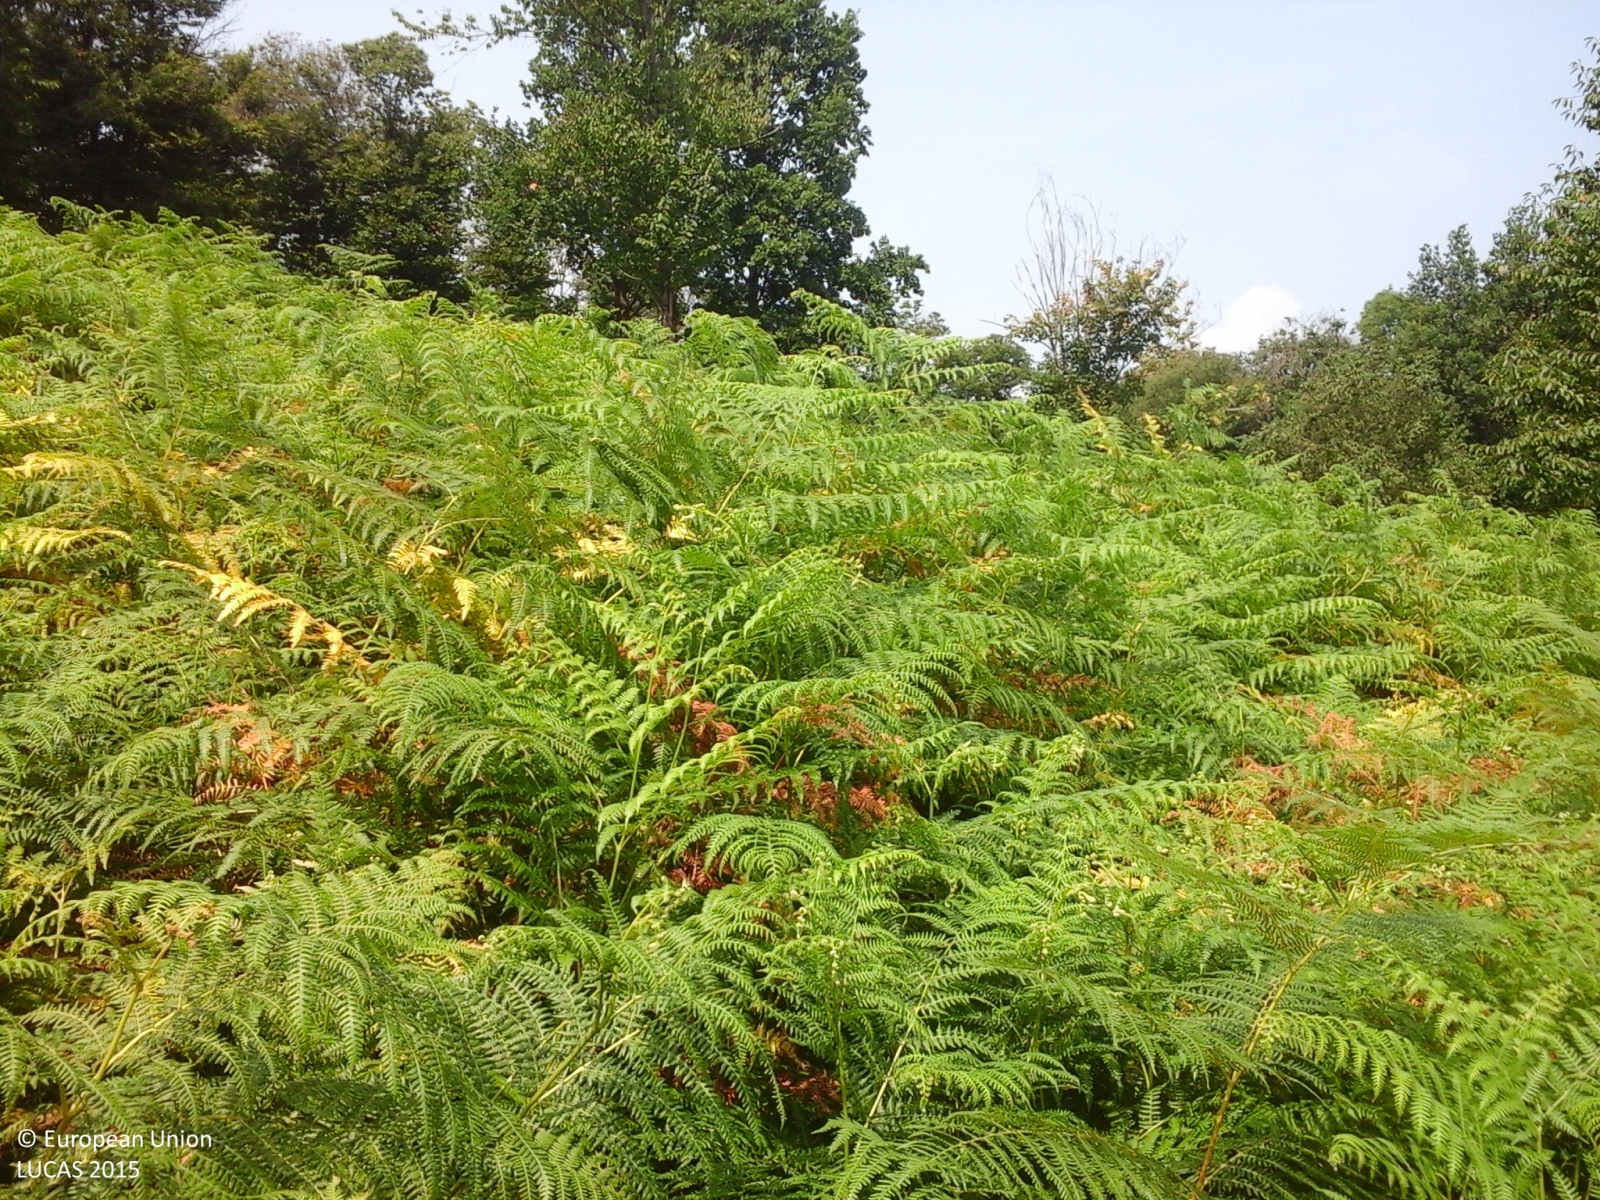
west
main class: Grassland
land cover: Grassland with sparse tree/shrub cover
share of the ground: > 75 %
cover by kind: herbaceous plants 95 %, broadleaved forest trees 5 %
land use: Semi-natural and natural areas not in use
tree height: > 5 m
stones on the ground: < 10 %
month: July
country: IT
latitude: 45.9652
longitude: 8.7243
